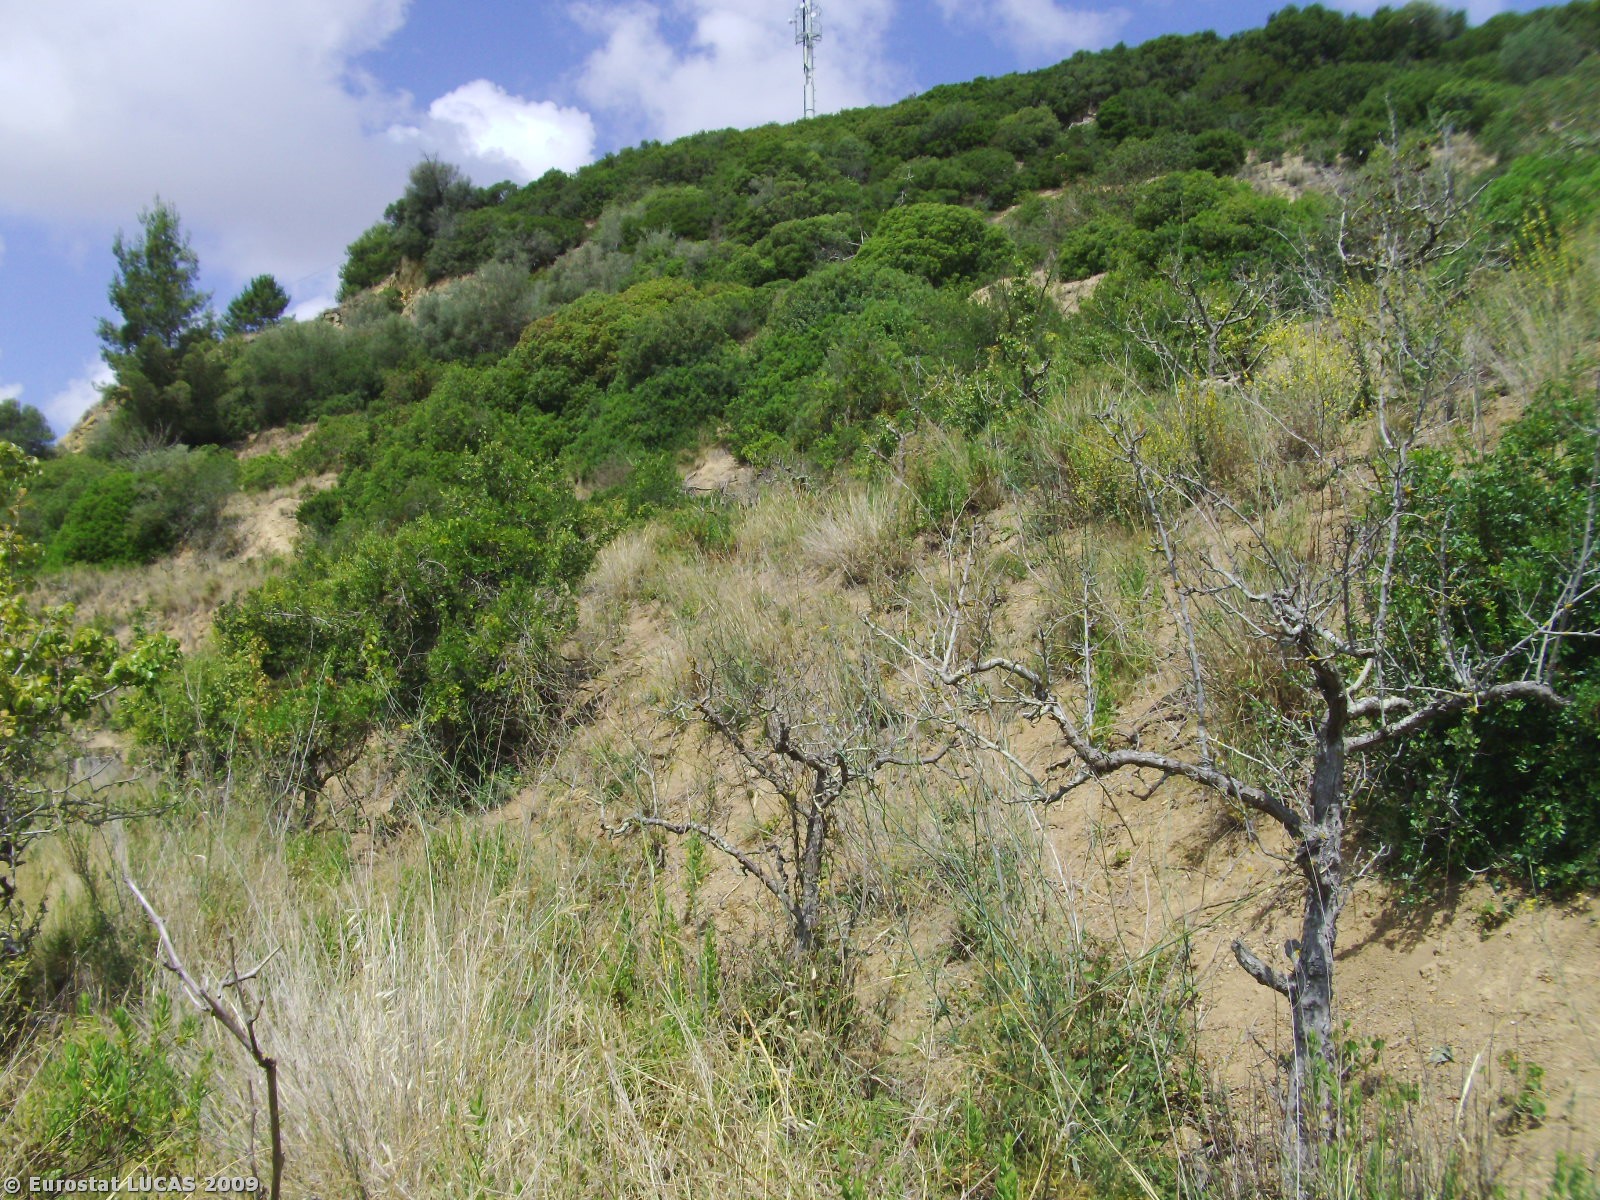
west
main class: Shrubland
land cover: Shrubland with sparse tree cover
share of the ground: 50 - 75 %
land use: Unused
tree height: < 5 m
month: July
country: PT
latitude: 39.0968
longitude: -9.2688
